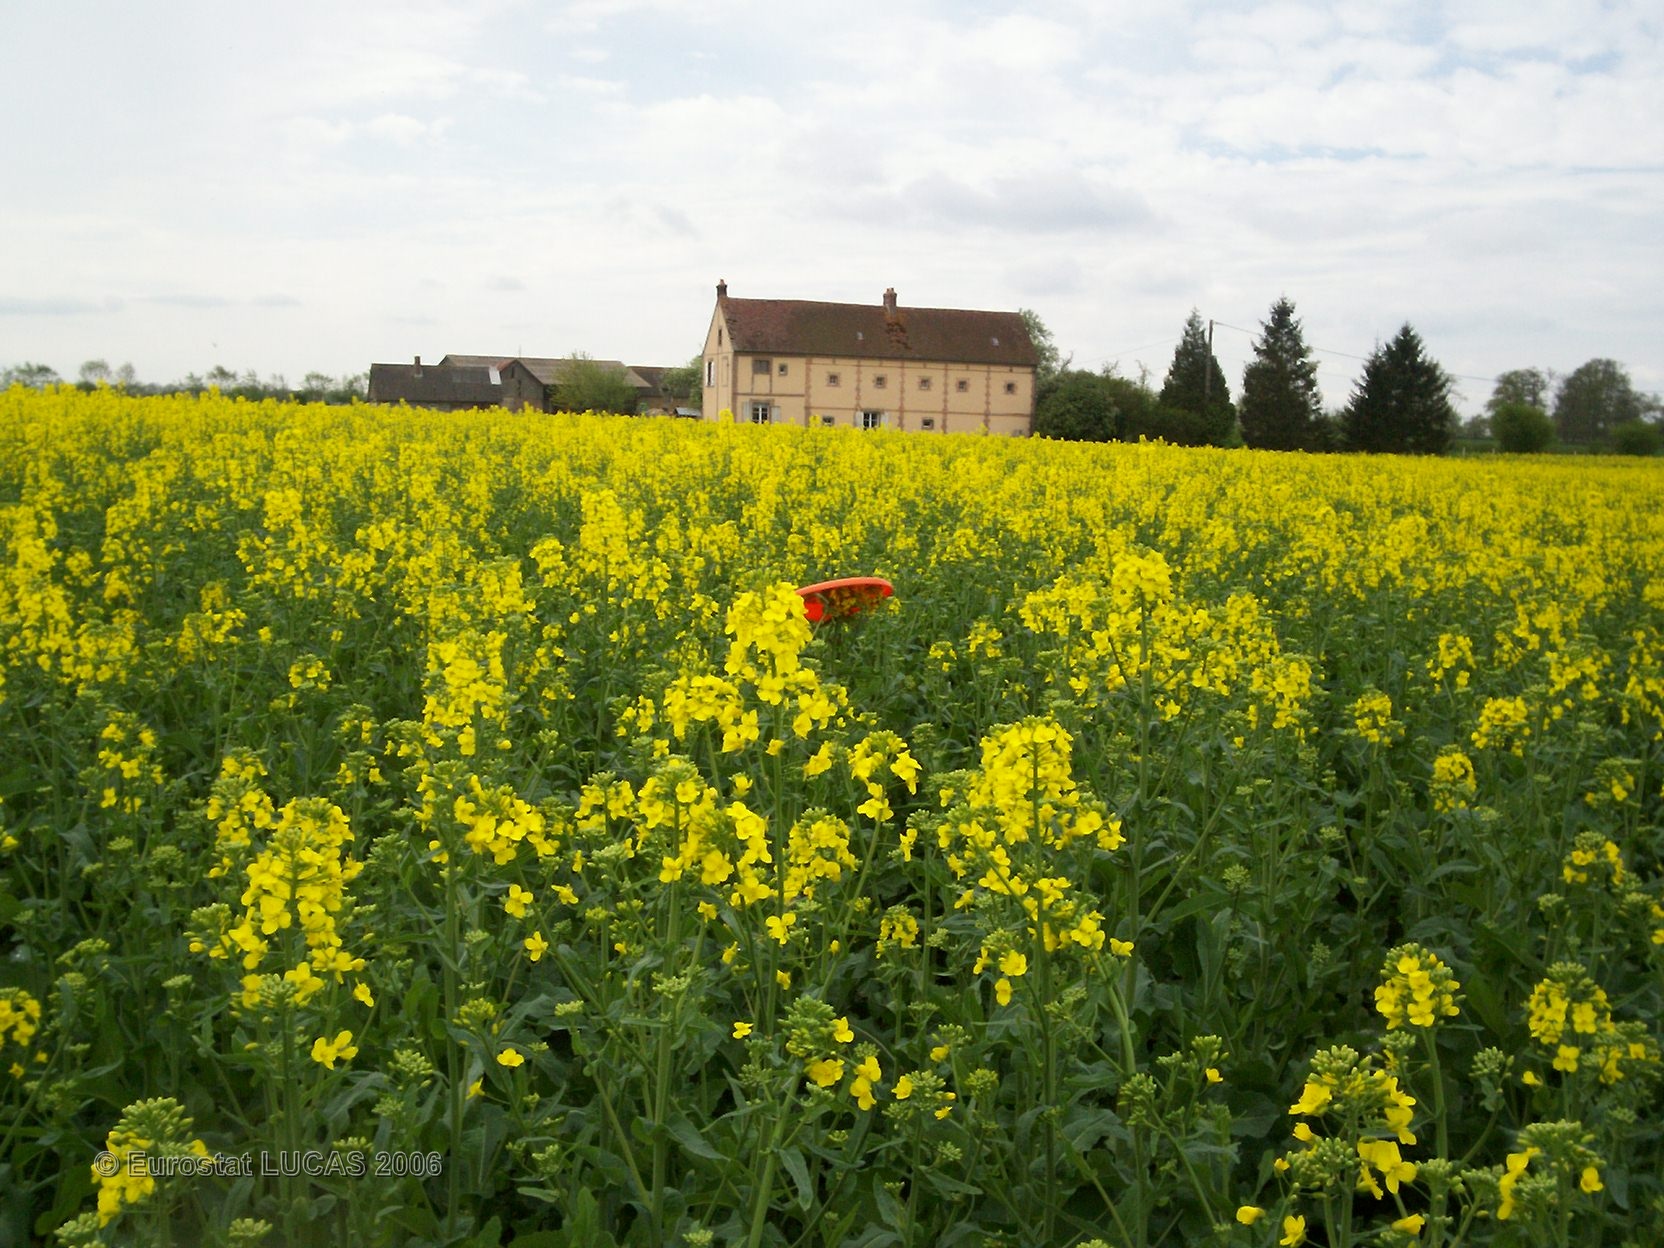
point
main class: Cropland
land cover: Rape and turnip rape
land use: Agriculture (excluding fallow land and kitchen gardens)
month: May
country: FR
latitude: 48.8856
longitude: 0.5512
